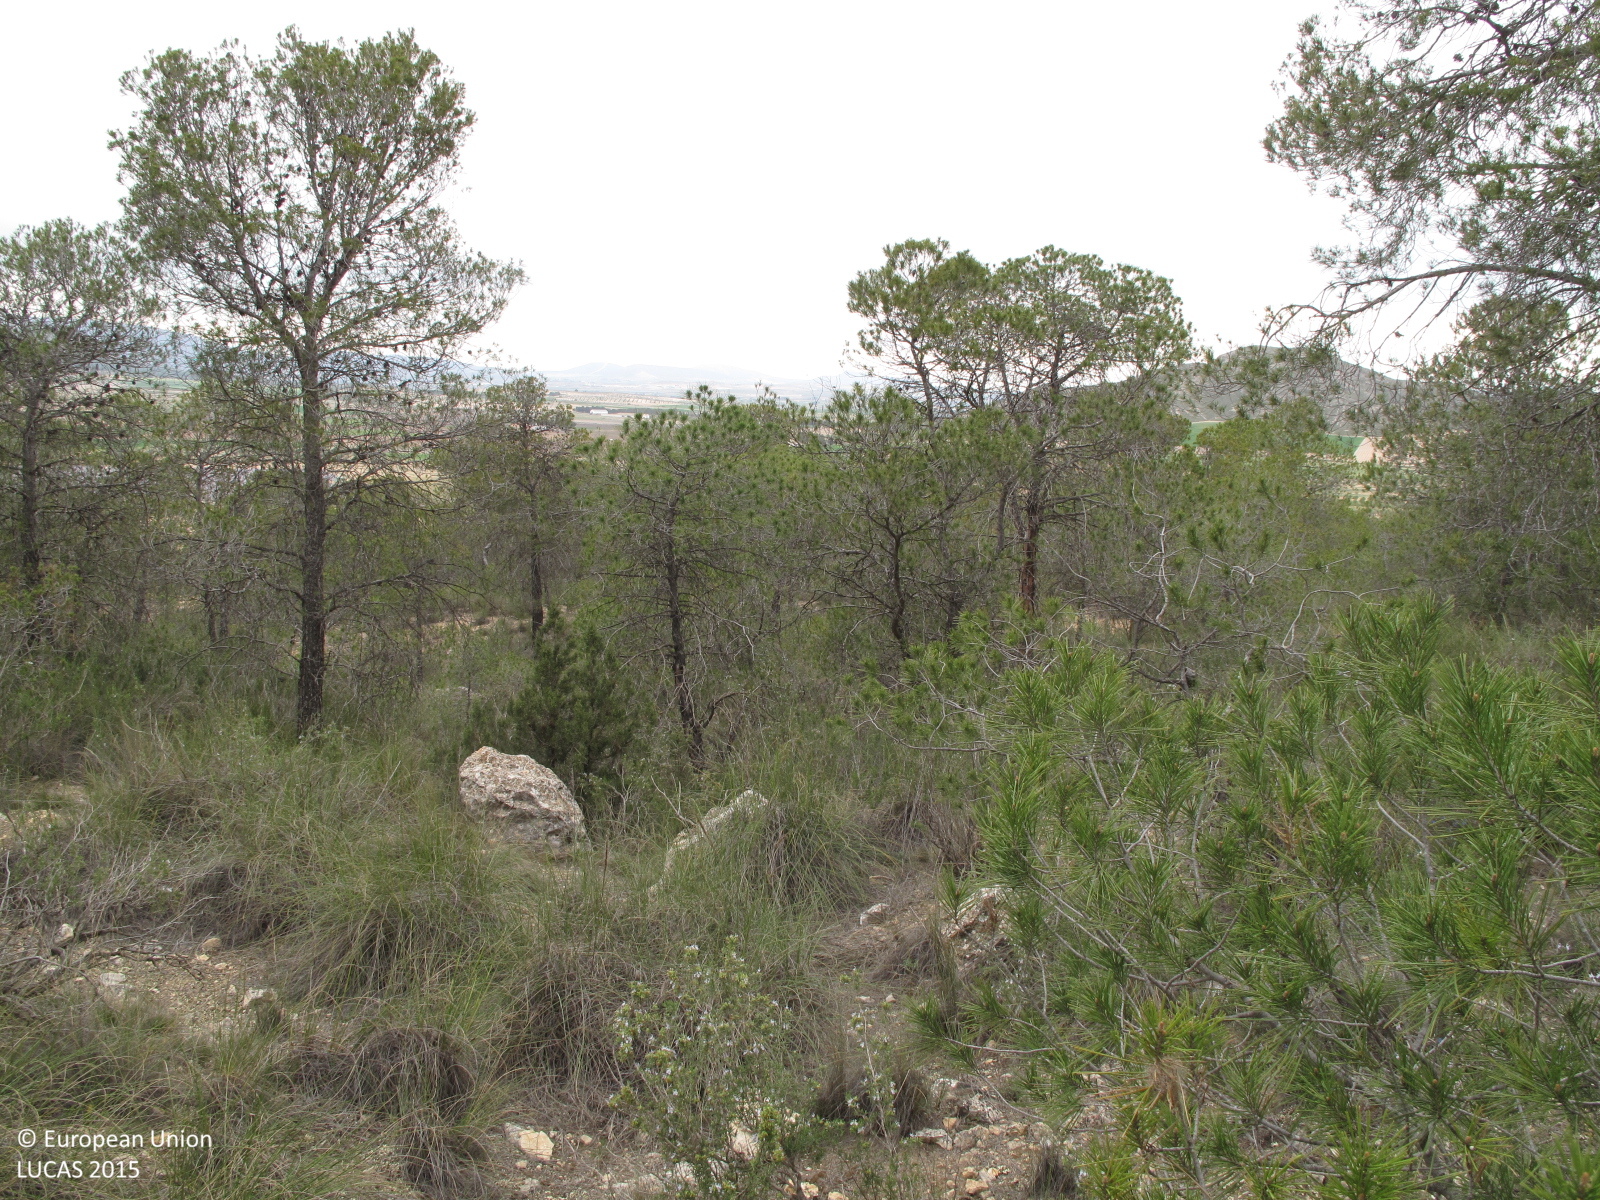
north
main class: Woodland
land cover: Pine dominated coniferous woodland
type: coniferous forest of the mediterranean region
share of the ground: 50 - 75 %
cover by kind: coniferous forest trees 60 %, shrubs 20 %, herbaceous plants 20 %
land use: Semi-natural and natural areas not in use
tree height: > 5 m
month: April
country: ES
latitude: 38.6111
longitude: -0.9577
